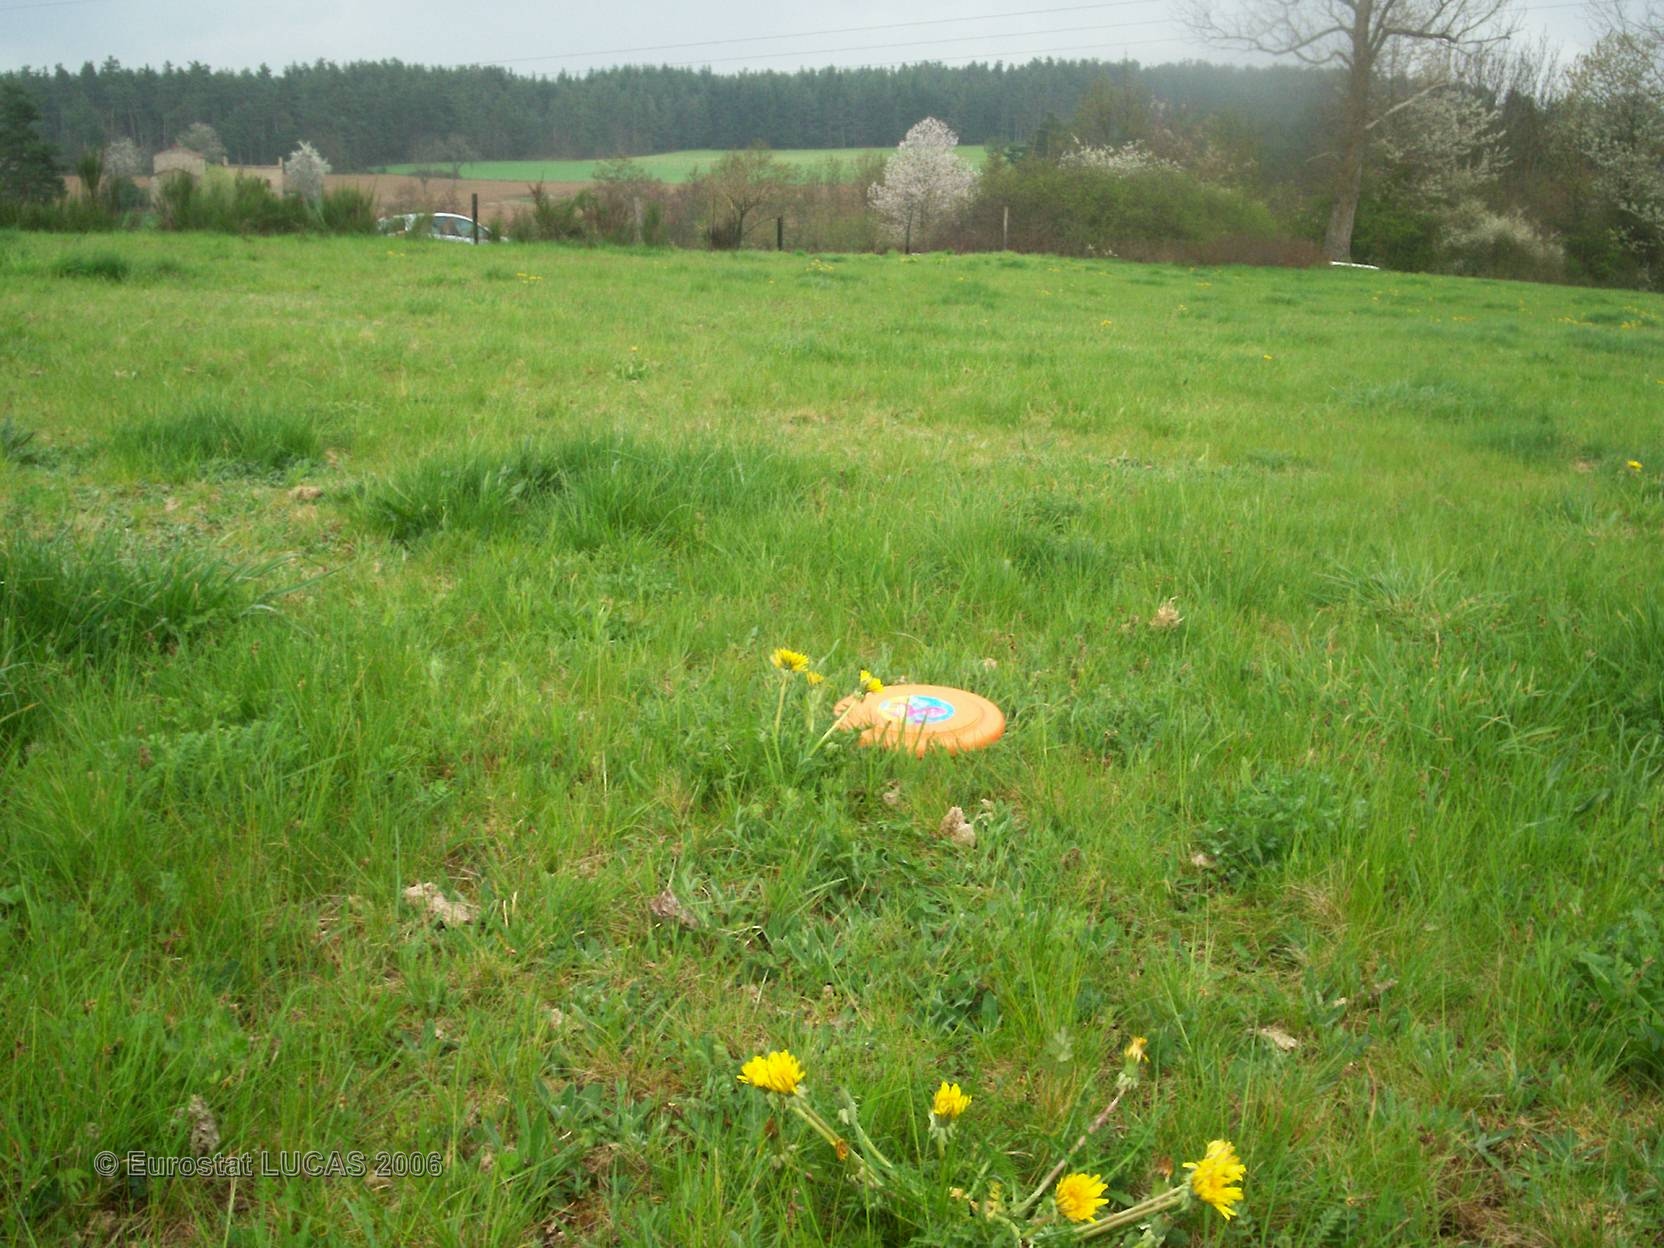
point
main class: Grassland
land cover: Grassland without tree/shrub cover
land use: Agriculture (excluding fallow land and kitchen gardens)
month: April
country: FR
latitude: 45.2536
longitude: 4.1808
